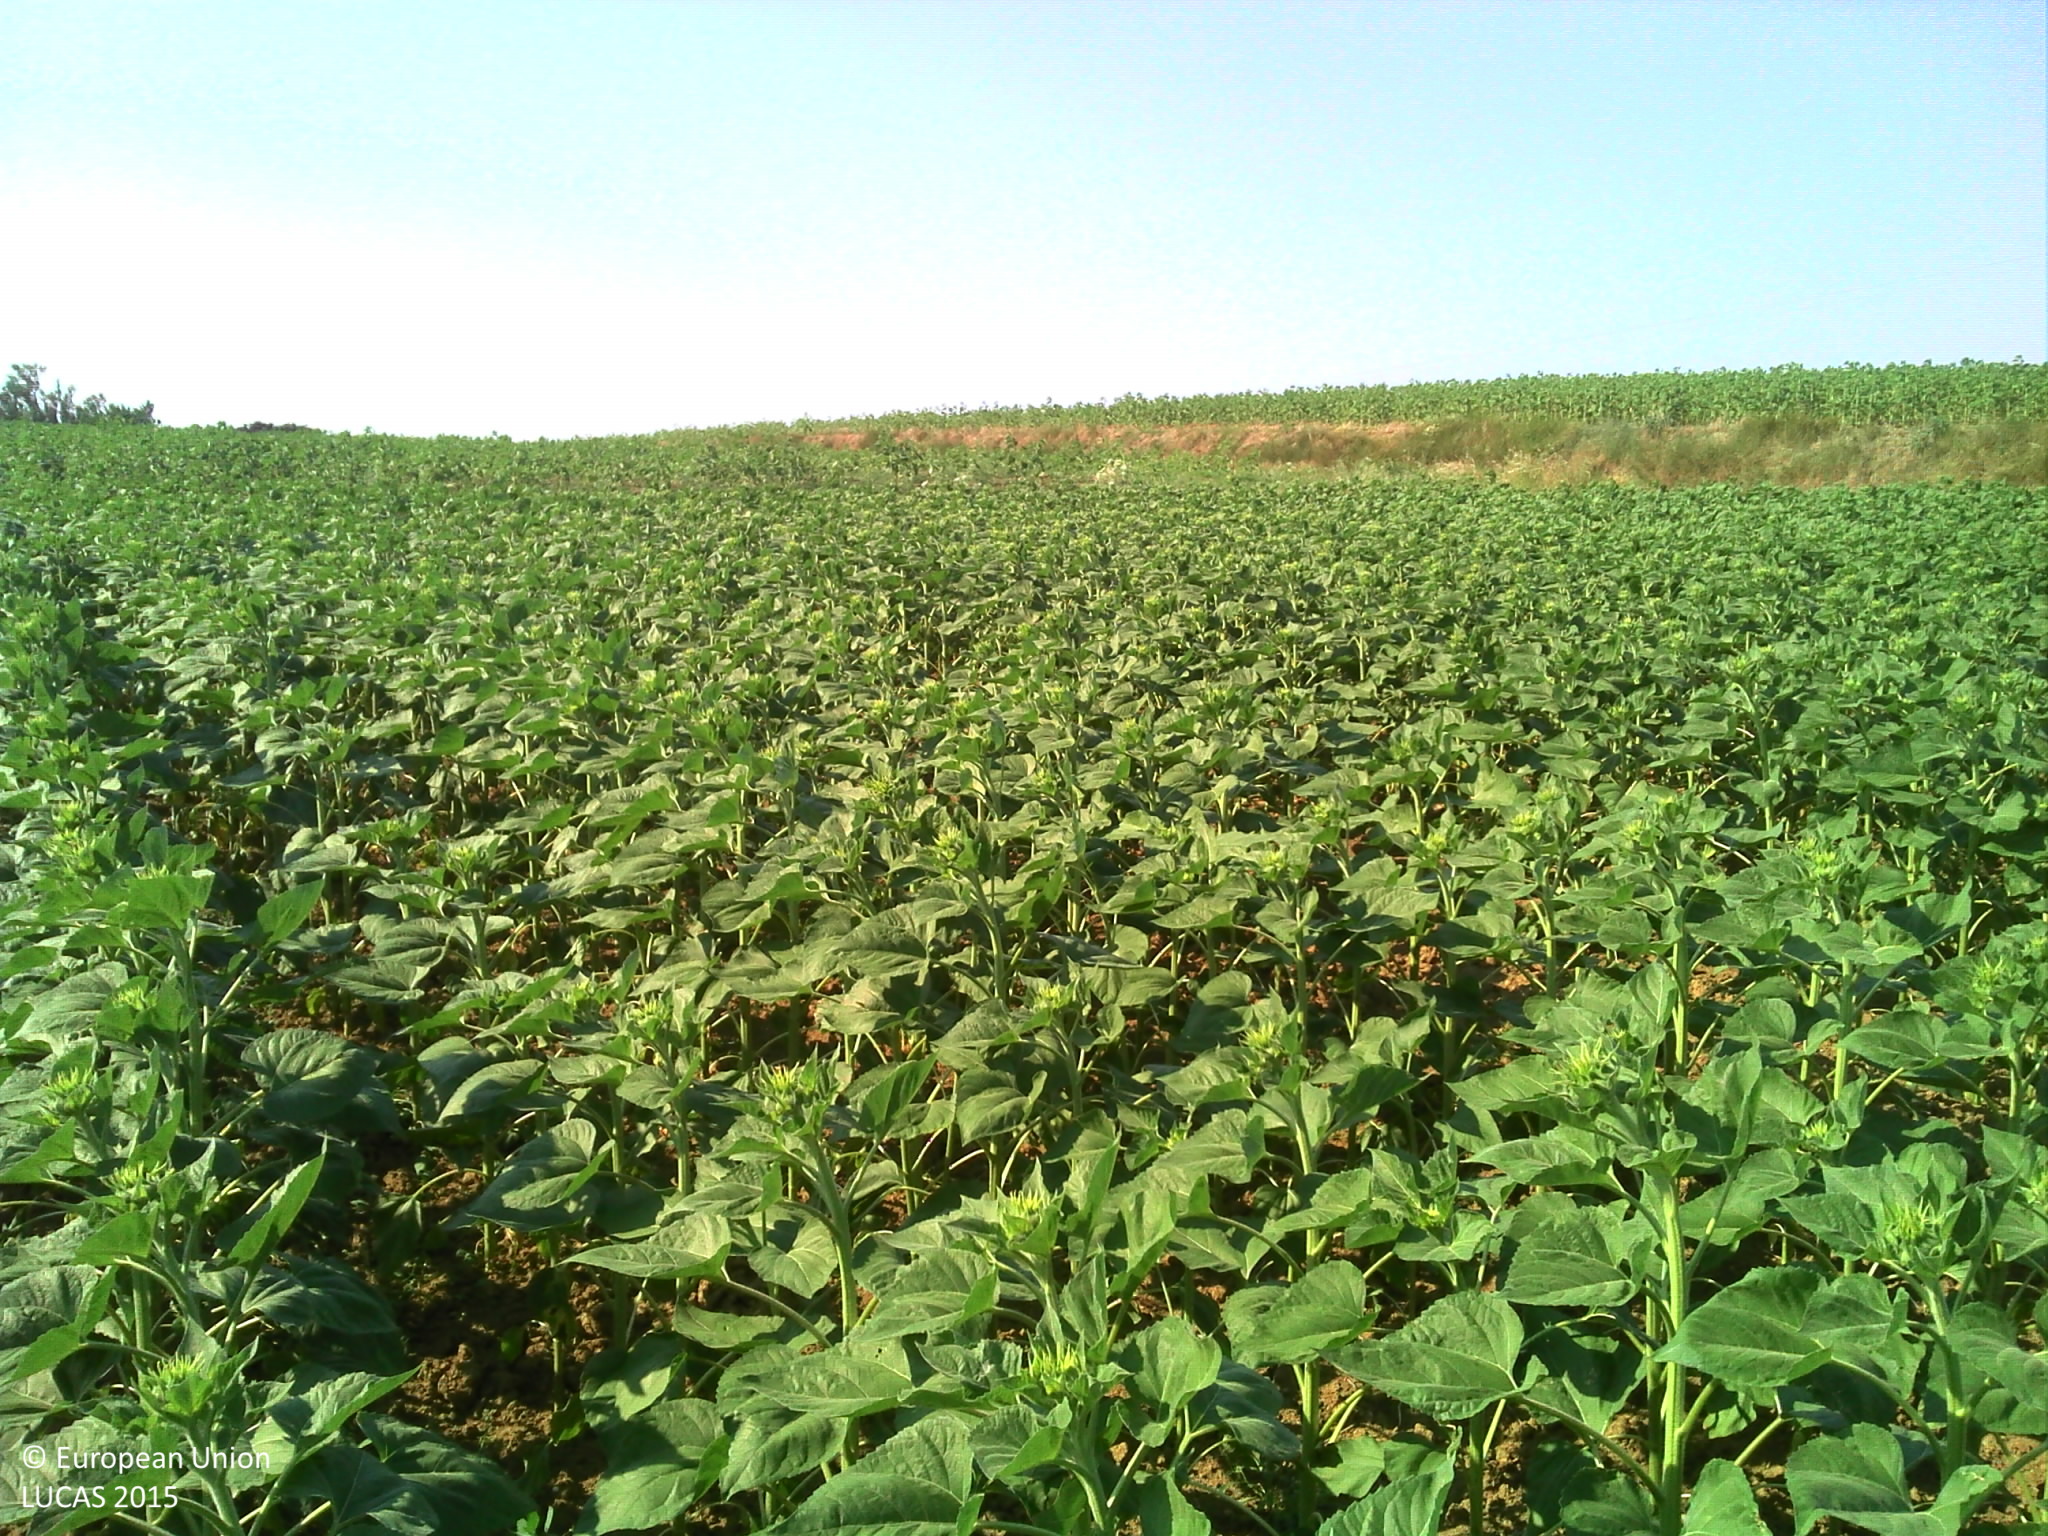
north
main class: Cropland
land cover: Sunflower
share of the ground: > 75 %
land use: Agriculture (excluding fallow land and kitchen gardens)
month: June
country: FR
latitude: 43.1771
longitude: 2.0725
